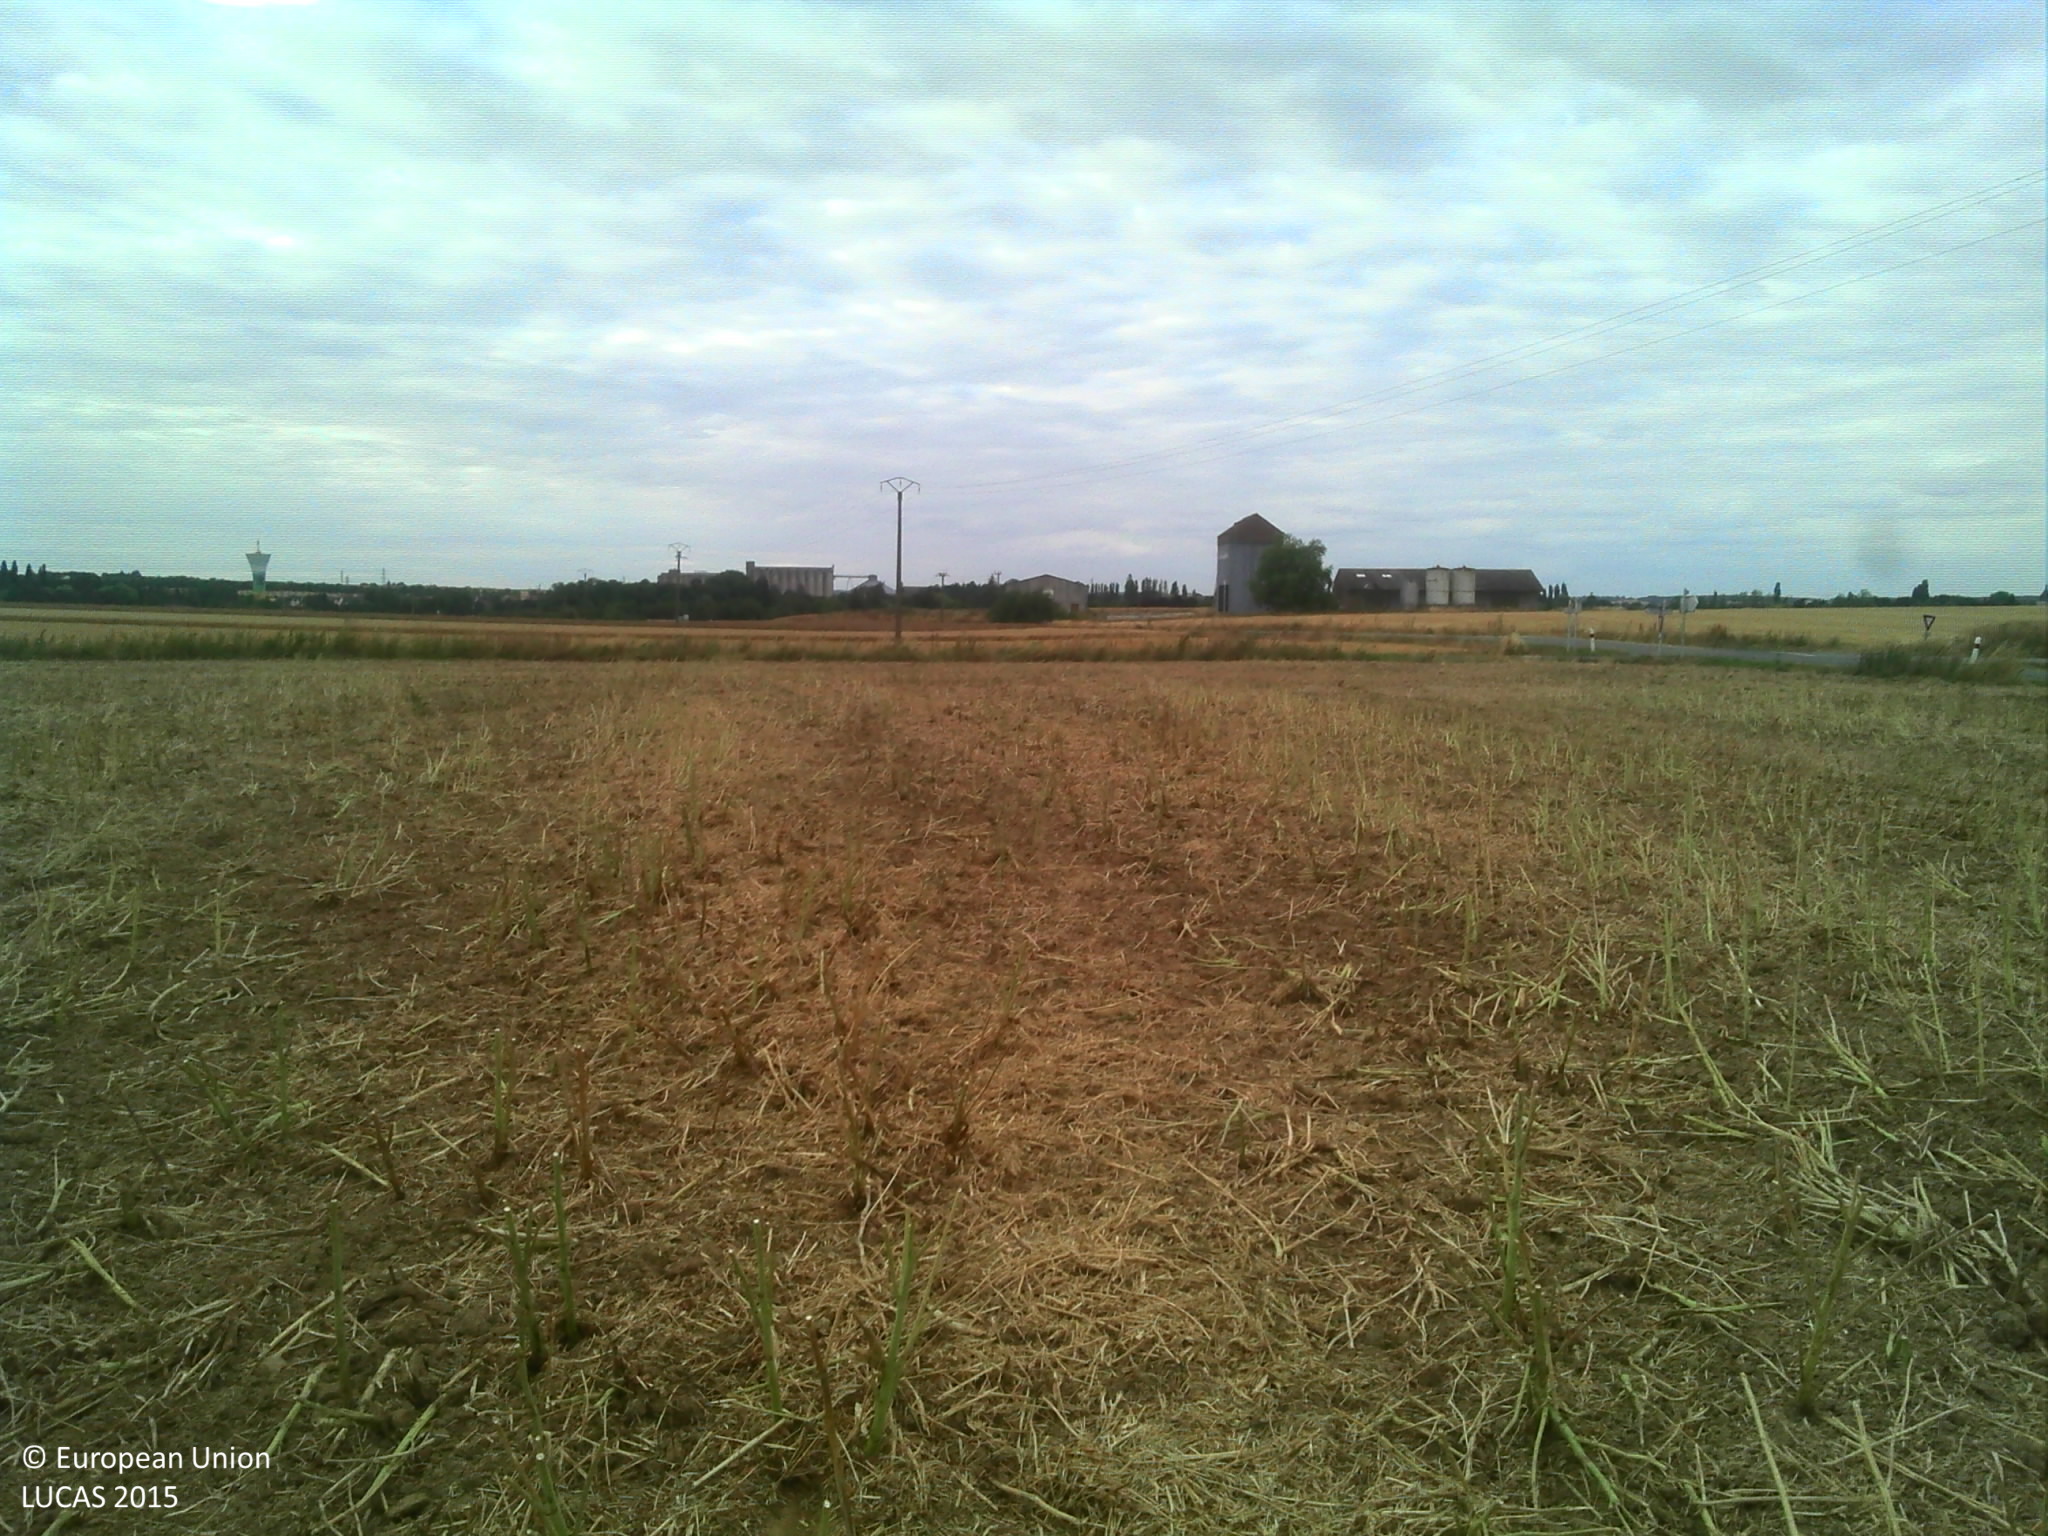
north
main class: Cropland
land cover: Rape and turnip rape
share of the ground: > 75 %
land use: Agriculture (excluding fallow land and kitchen gardens)
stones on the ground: < 10 %
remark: Harvested field
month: July
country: FR
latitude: 48.4350
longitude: 1.2363
